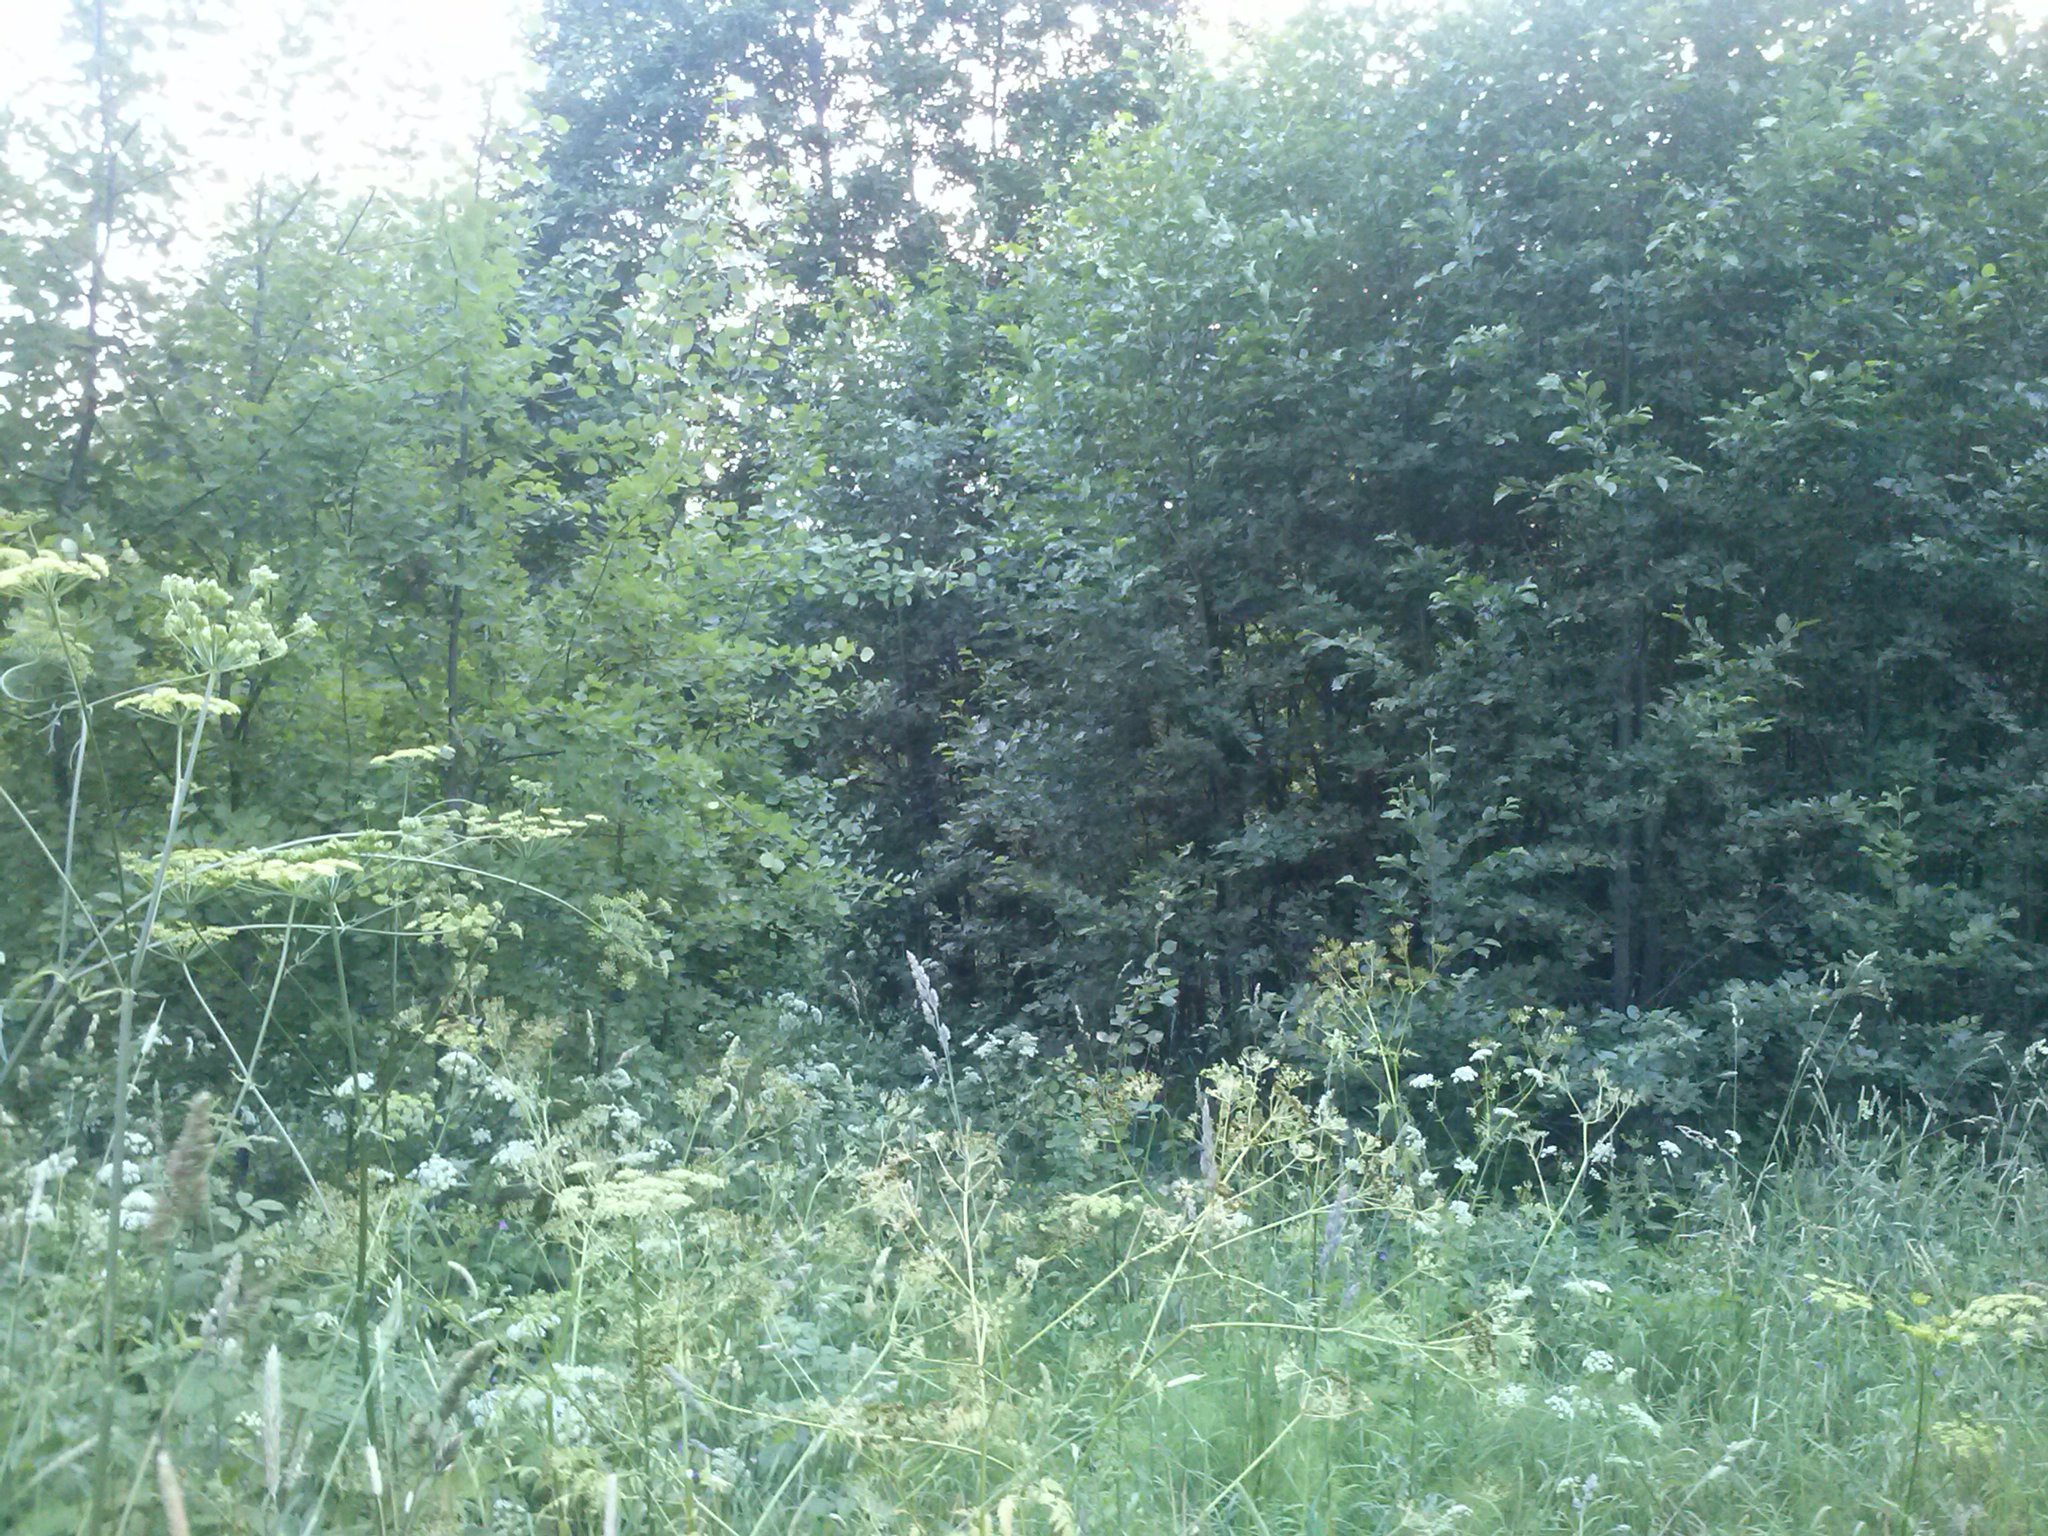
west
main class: Grassland
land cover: Spontaneously vegetated surfaces
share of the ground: > 75 %
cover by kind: herbaceous plants 95 %, shrubs 5 %
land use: Semi-natural and natural areas not in use
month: July
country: LV
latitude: 56.8521
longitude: 27.5102
